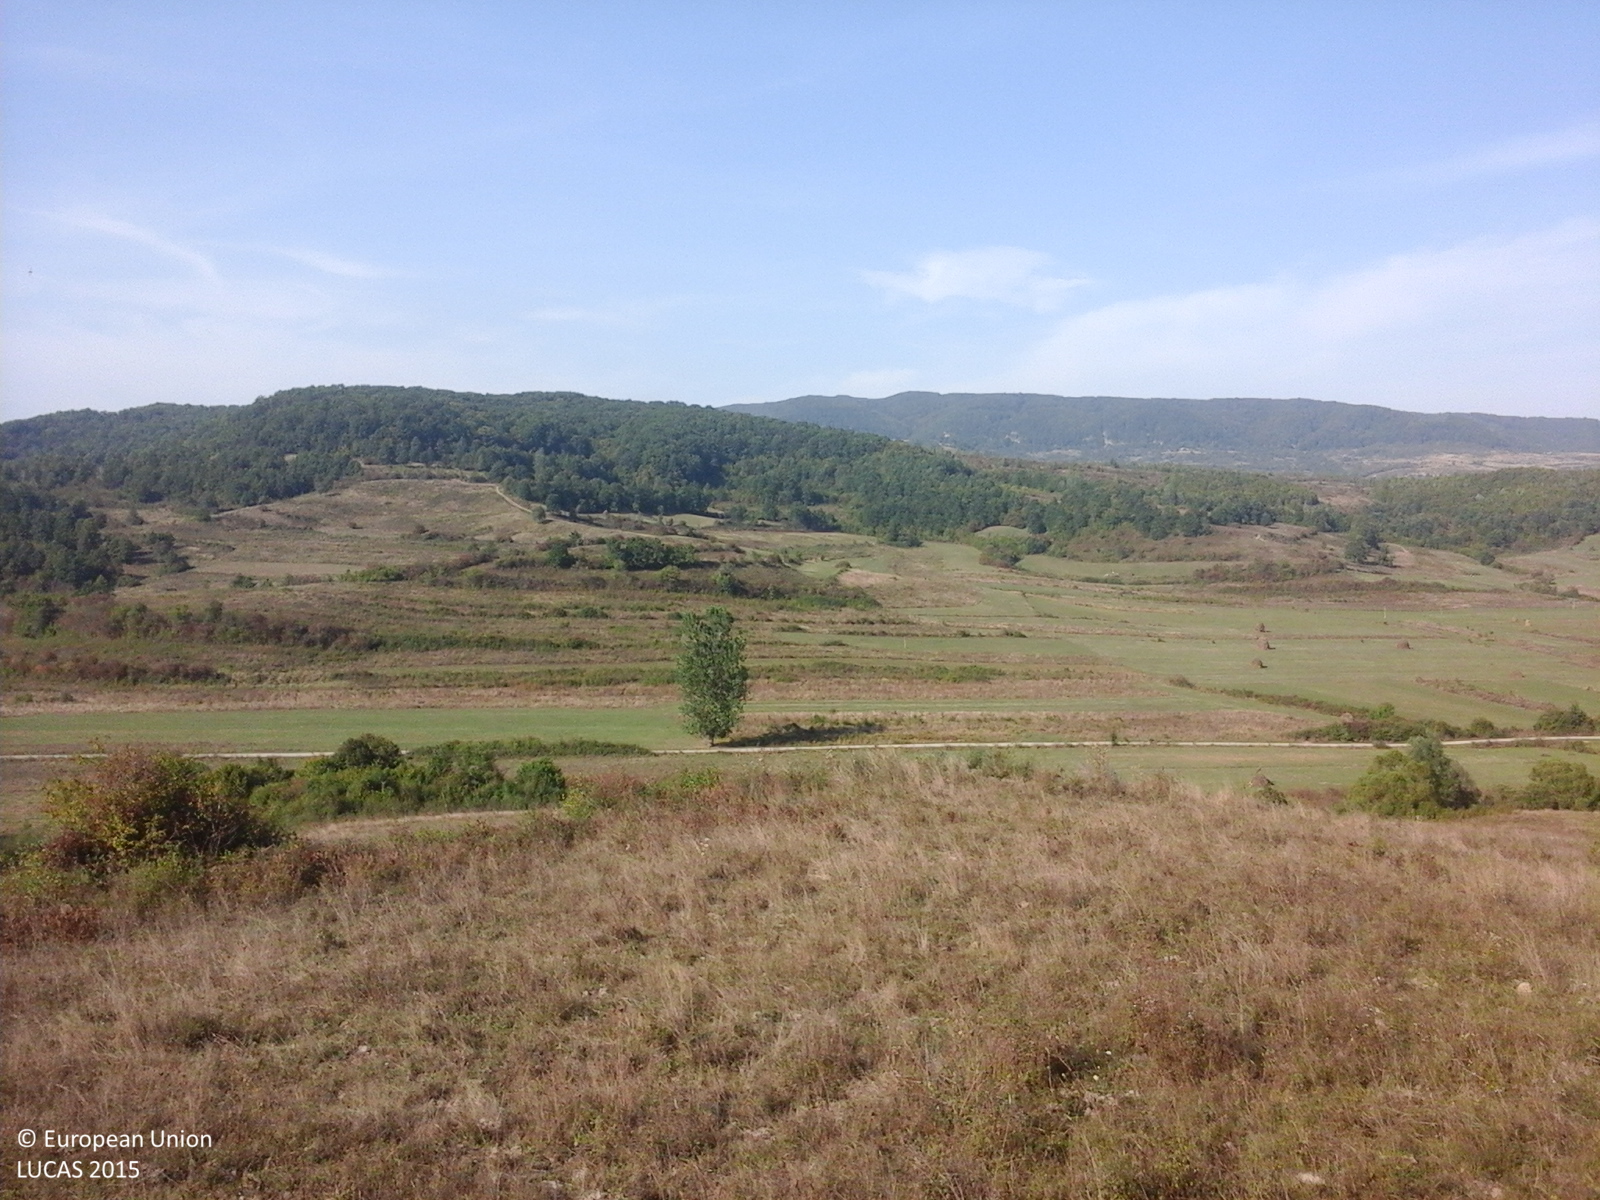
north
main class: Grassland
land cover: Spontaneously vegetated surfaces
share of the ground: > 75 %
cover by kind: herbaceous plants 100 %
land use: Fallow land
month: September
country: RO
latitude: 47.3420
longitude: 23.7229
